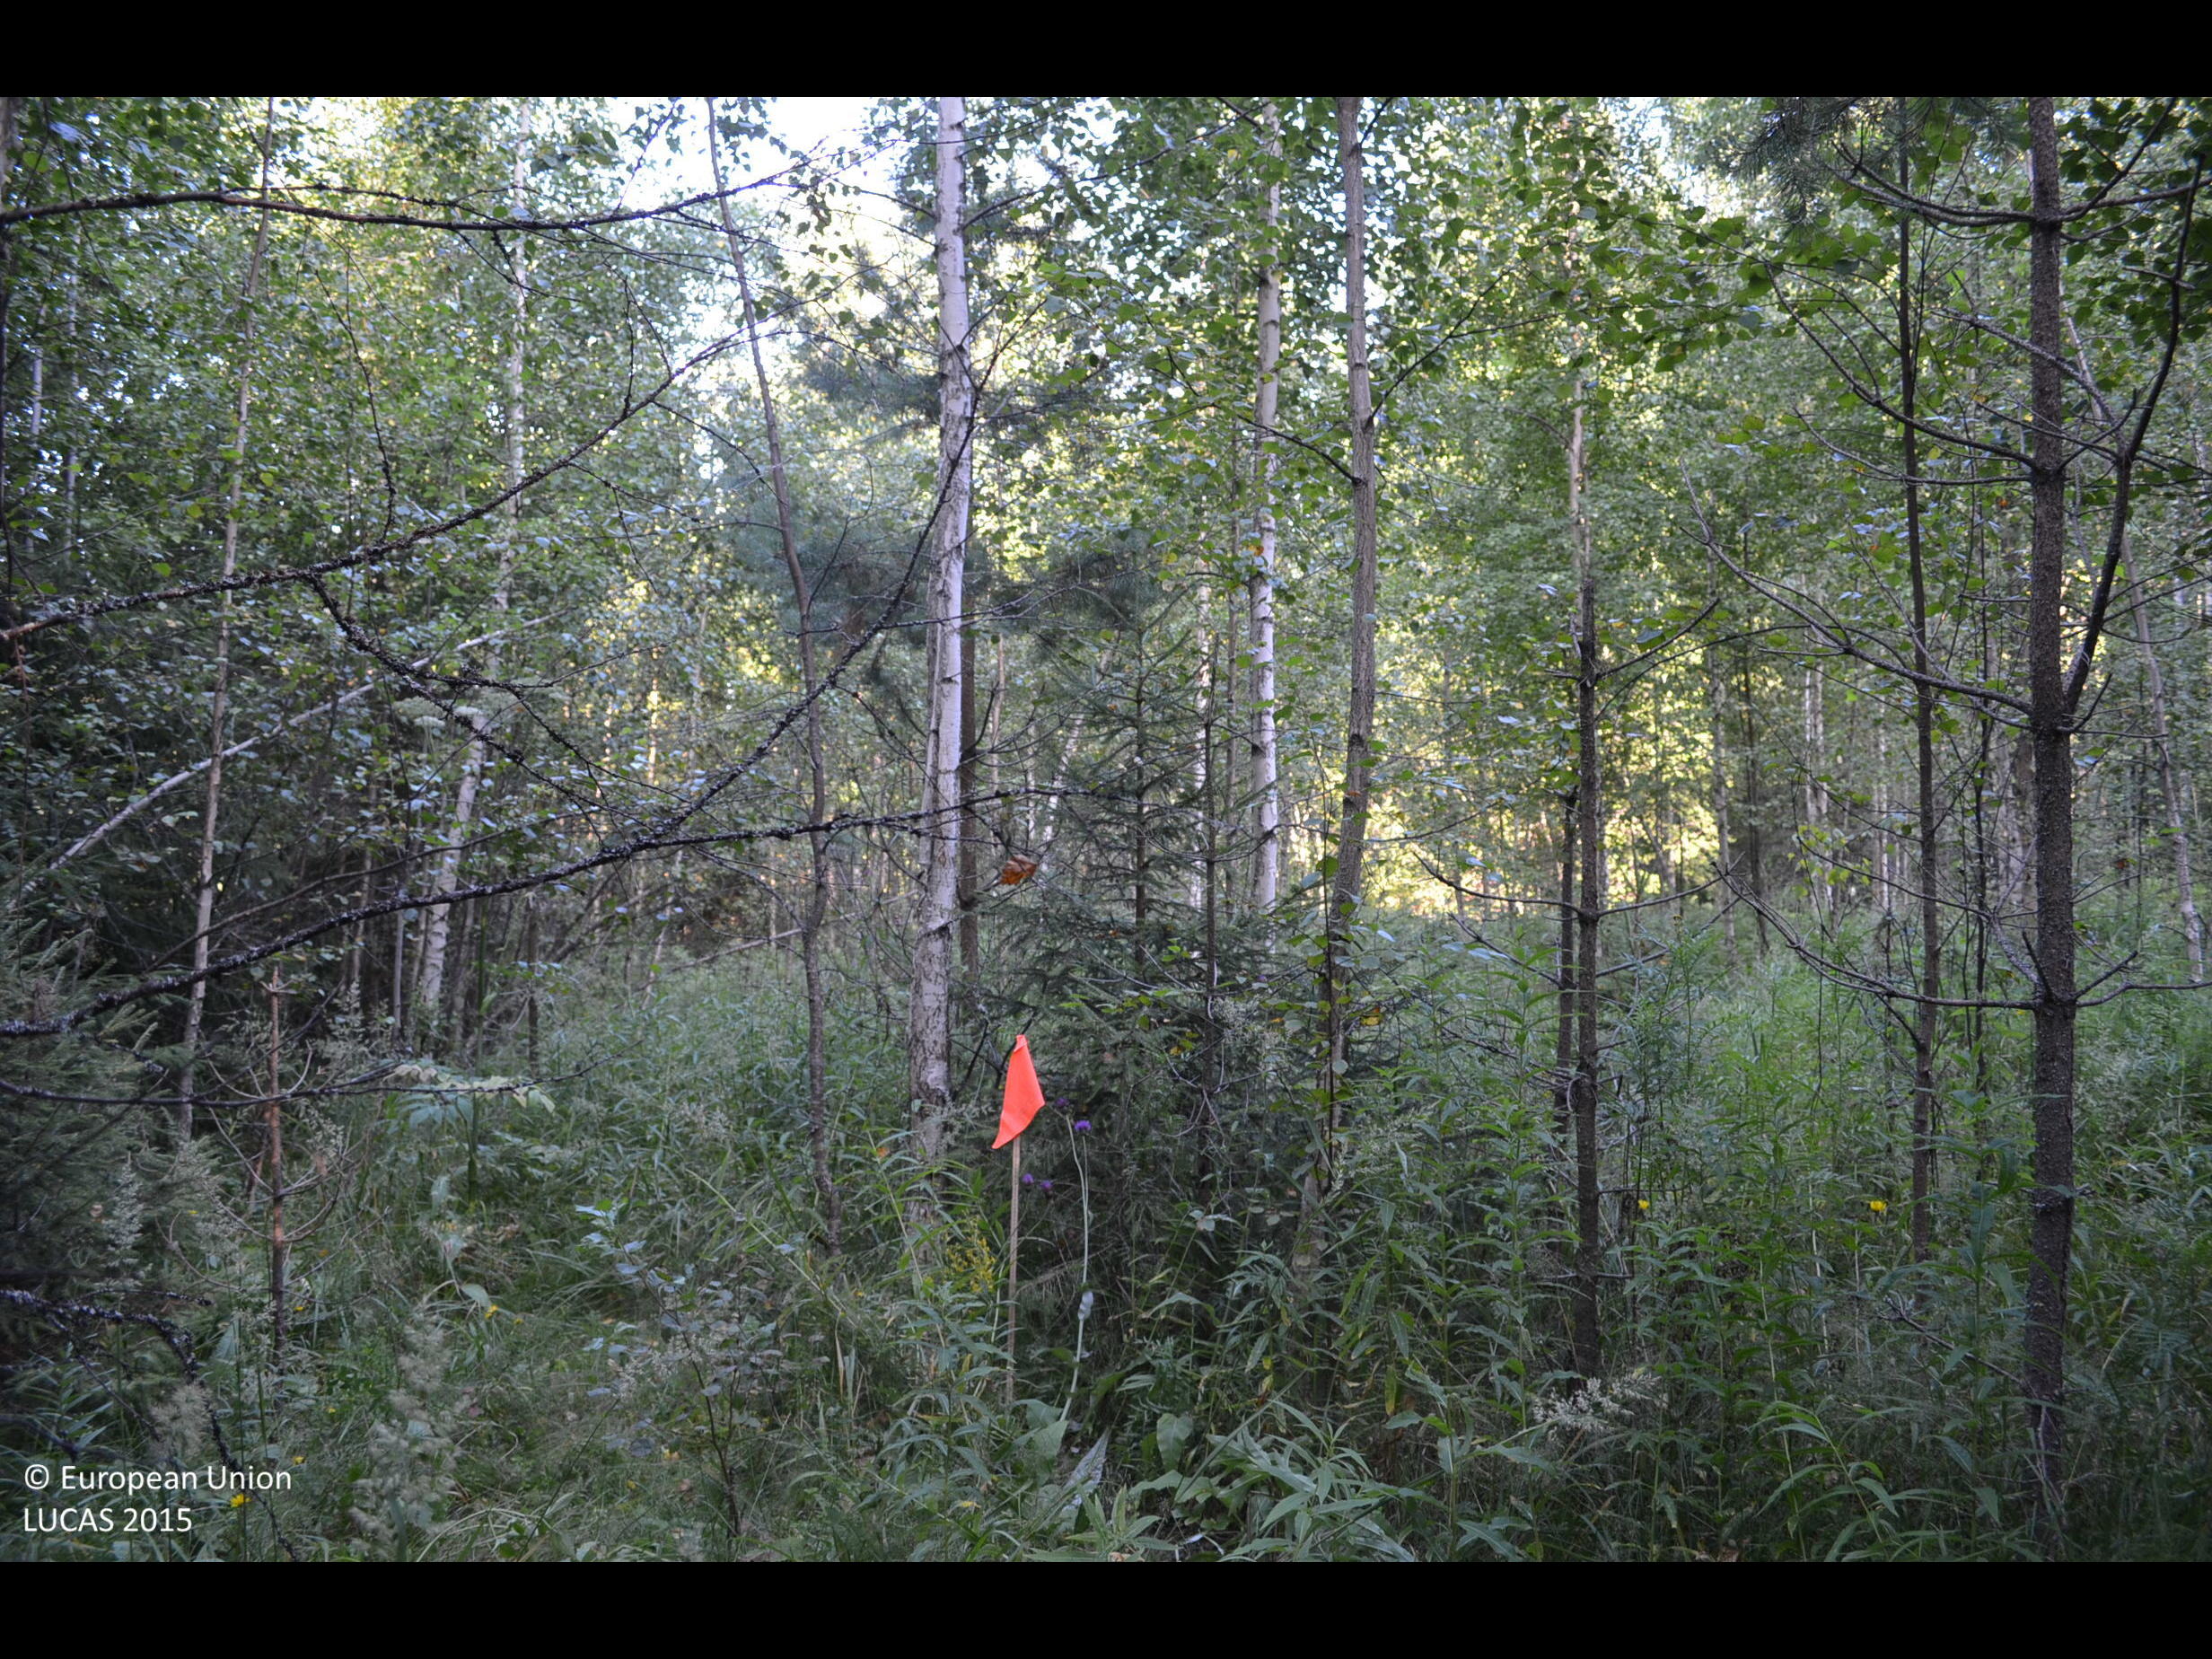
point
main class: Woodland
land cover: Broadleaved woodland
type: boreal forest
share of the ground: > 75 %
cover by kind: broadleaved forest trees 65 %, herbaceous plants 20 %, coniferous forest trees 15 %
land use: Forestry
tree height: > 5 m
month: August
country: FI
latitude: 62.0922
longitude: 24.2804
